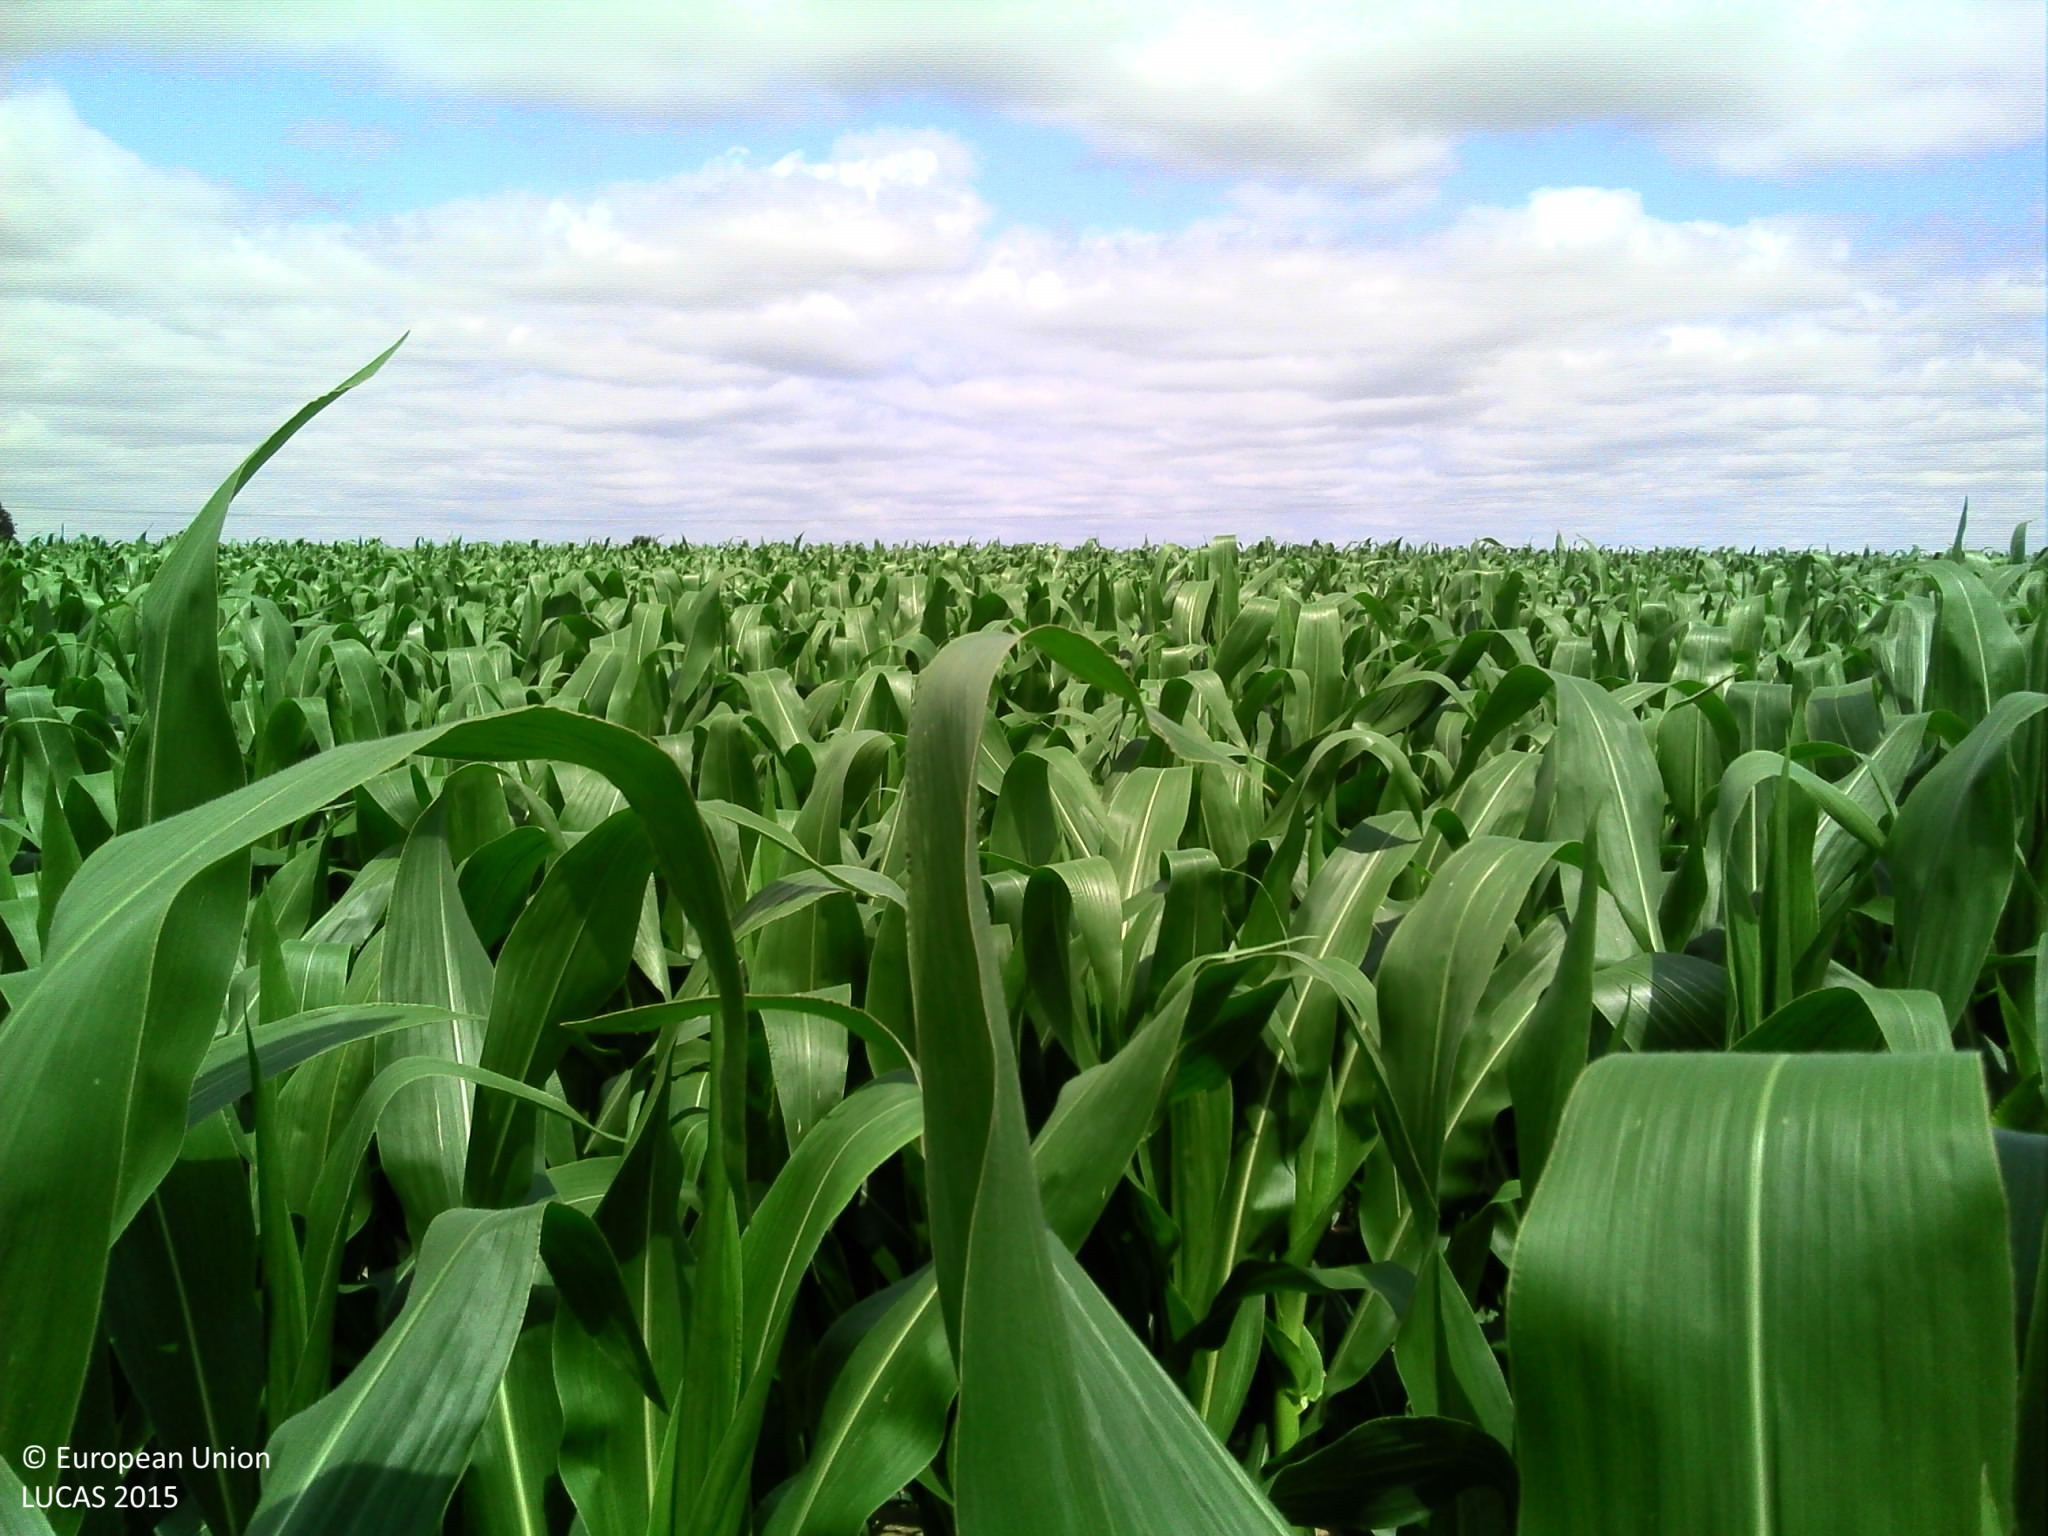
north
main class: Cropland
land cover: Maize
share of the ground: 50 - 75 %
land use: Agriculture (excluding fallow land and kitchen gardens)
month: July
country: FR
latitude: 47.6566
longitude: -1.8315
